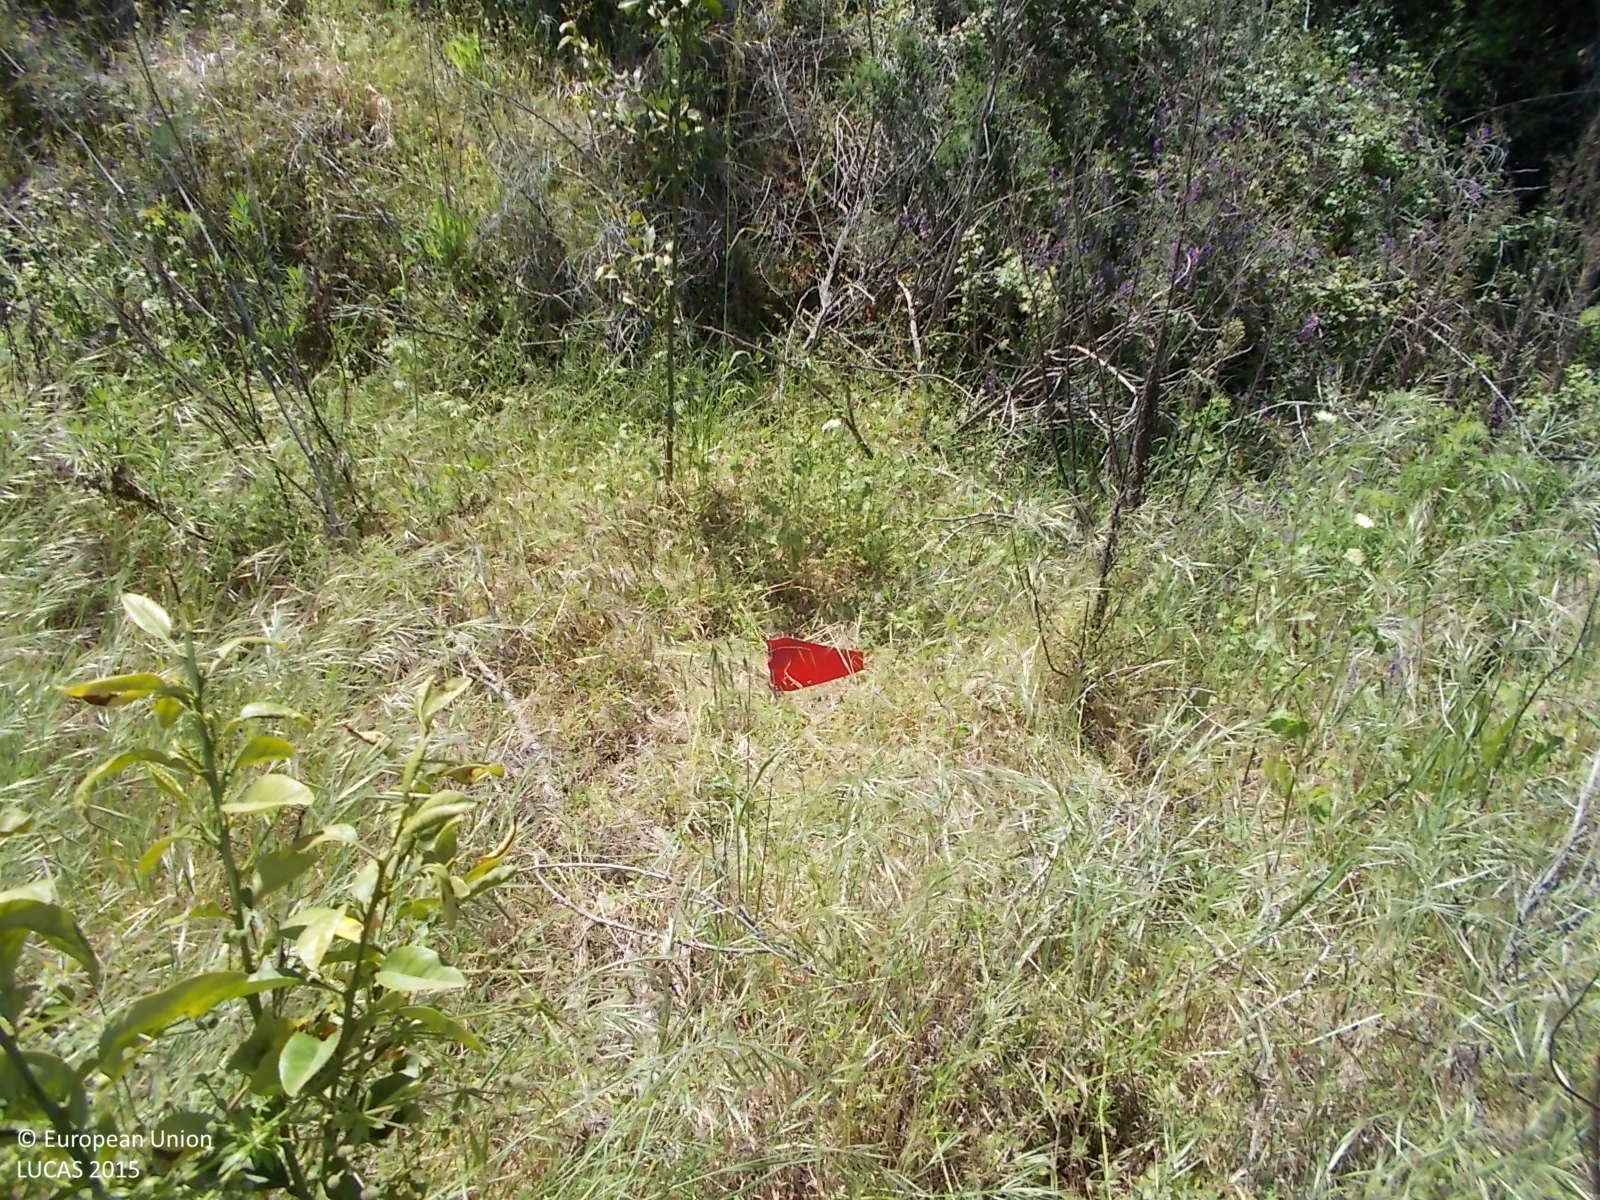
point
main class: Cropland
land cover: Other citrus fruit
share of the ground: 10 - 25 %
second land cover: Spontaneously vegetated surfaces
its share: > 75 %
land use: Abandoned areas
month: April
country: CY
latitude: 34.8248
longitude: 33.0994
